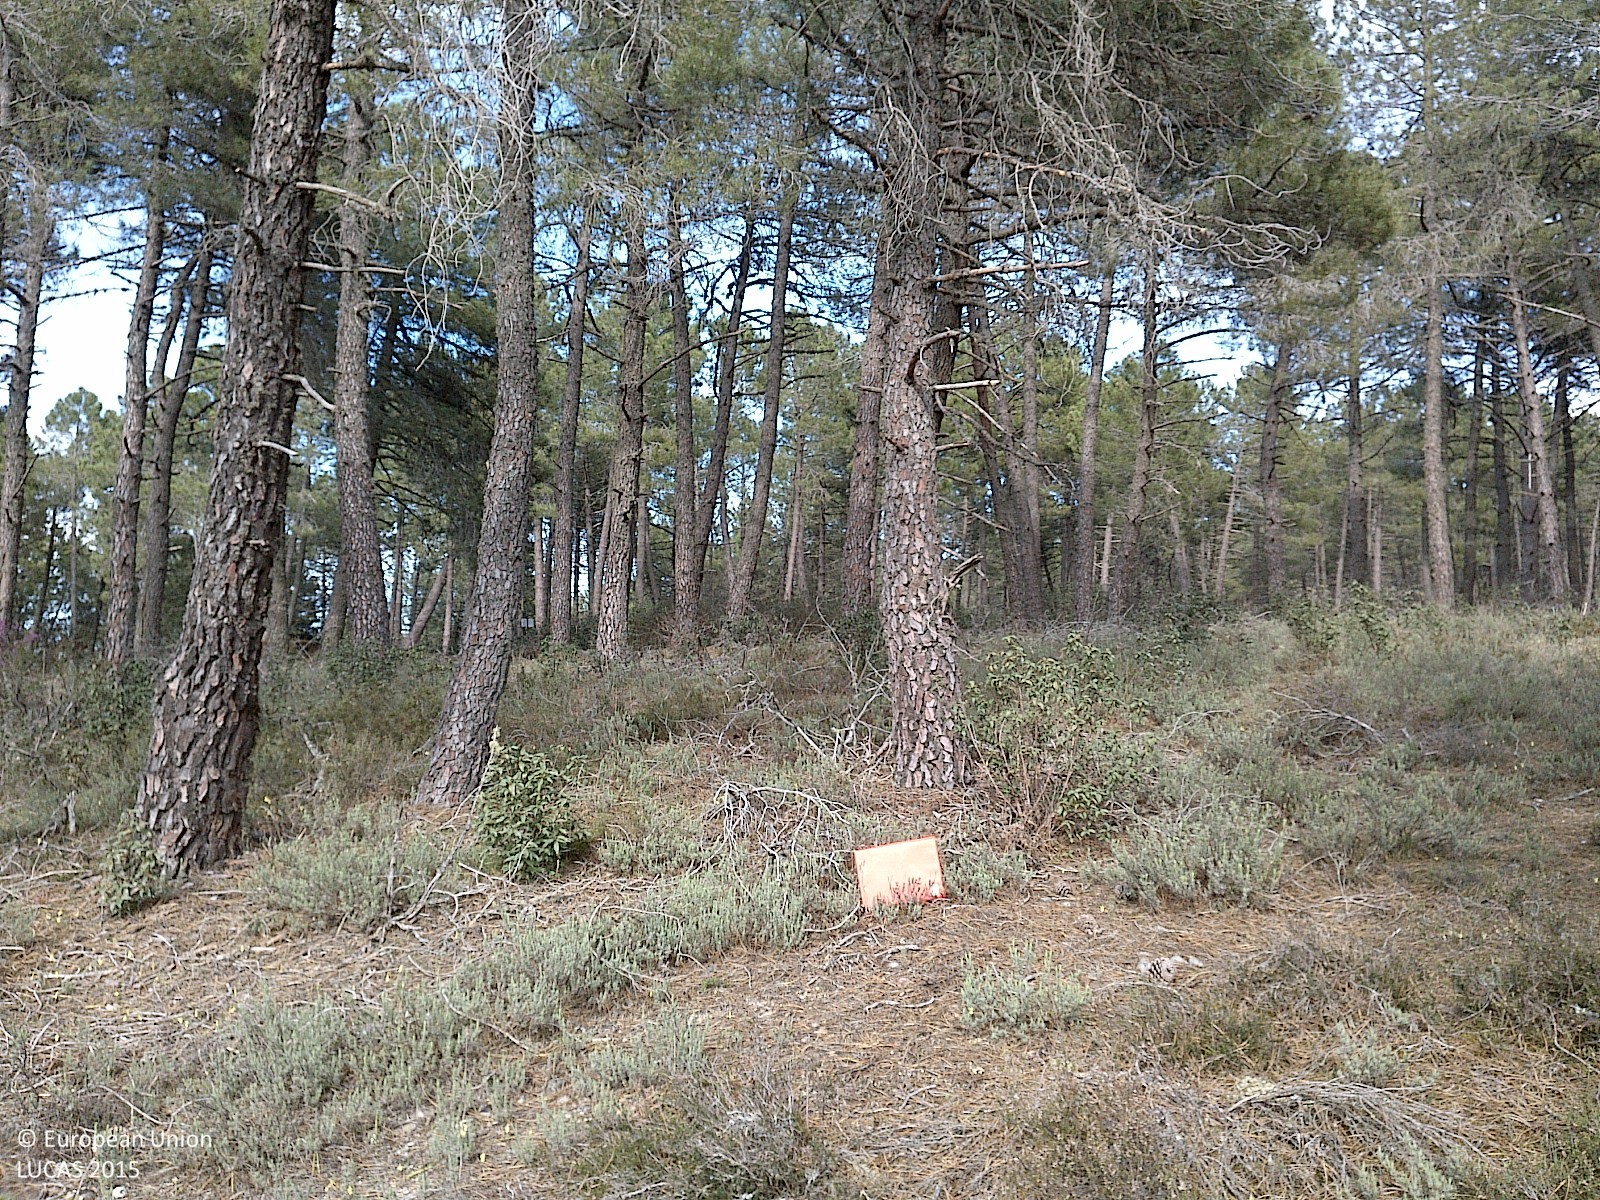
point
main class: Woodland
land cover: Pine dominated coniferous woodland
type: coniferous forest of the mediterranean region
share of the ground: 50 - 75 %
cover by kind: coniferous forest trees 55 %, shrubs 25 %, herbaceous plants 20 %
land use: Forestry
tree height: > 5 m
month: April
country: ES
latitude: 41.8686
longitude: -3.2658
